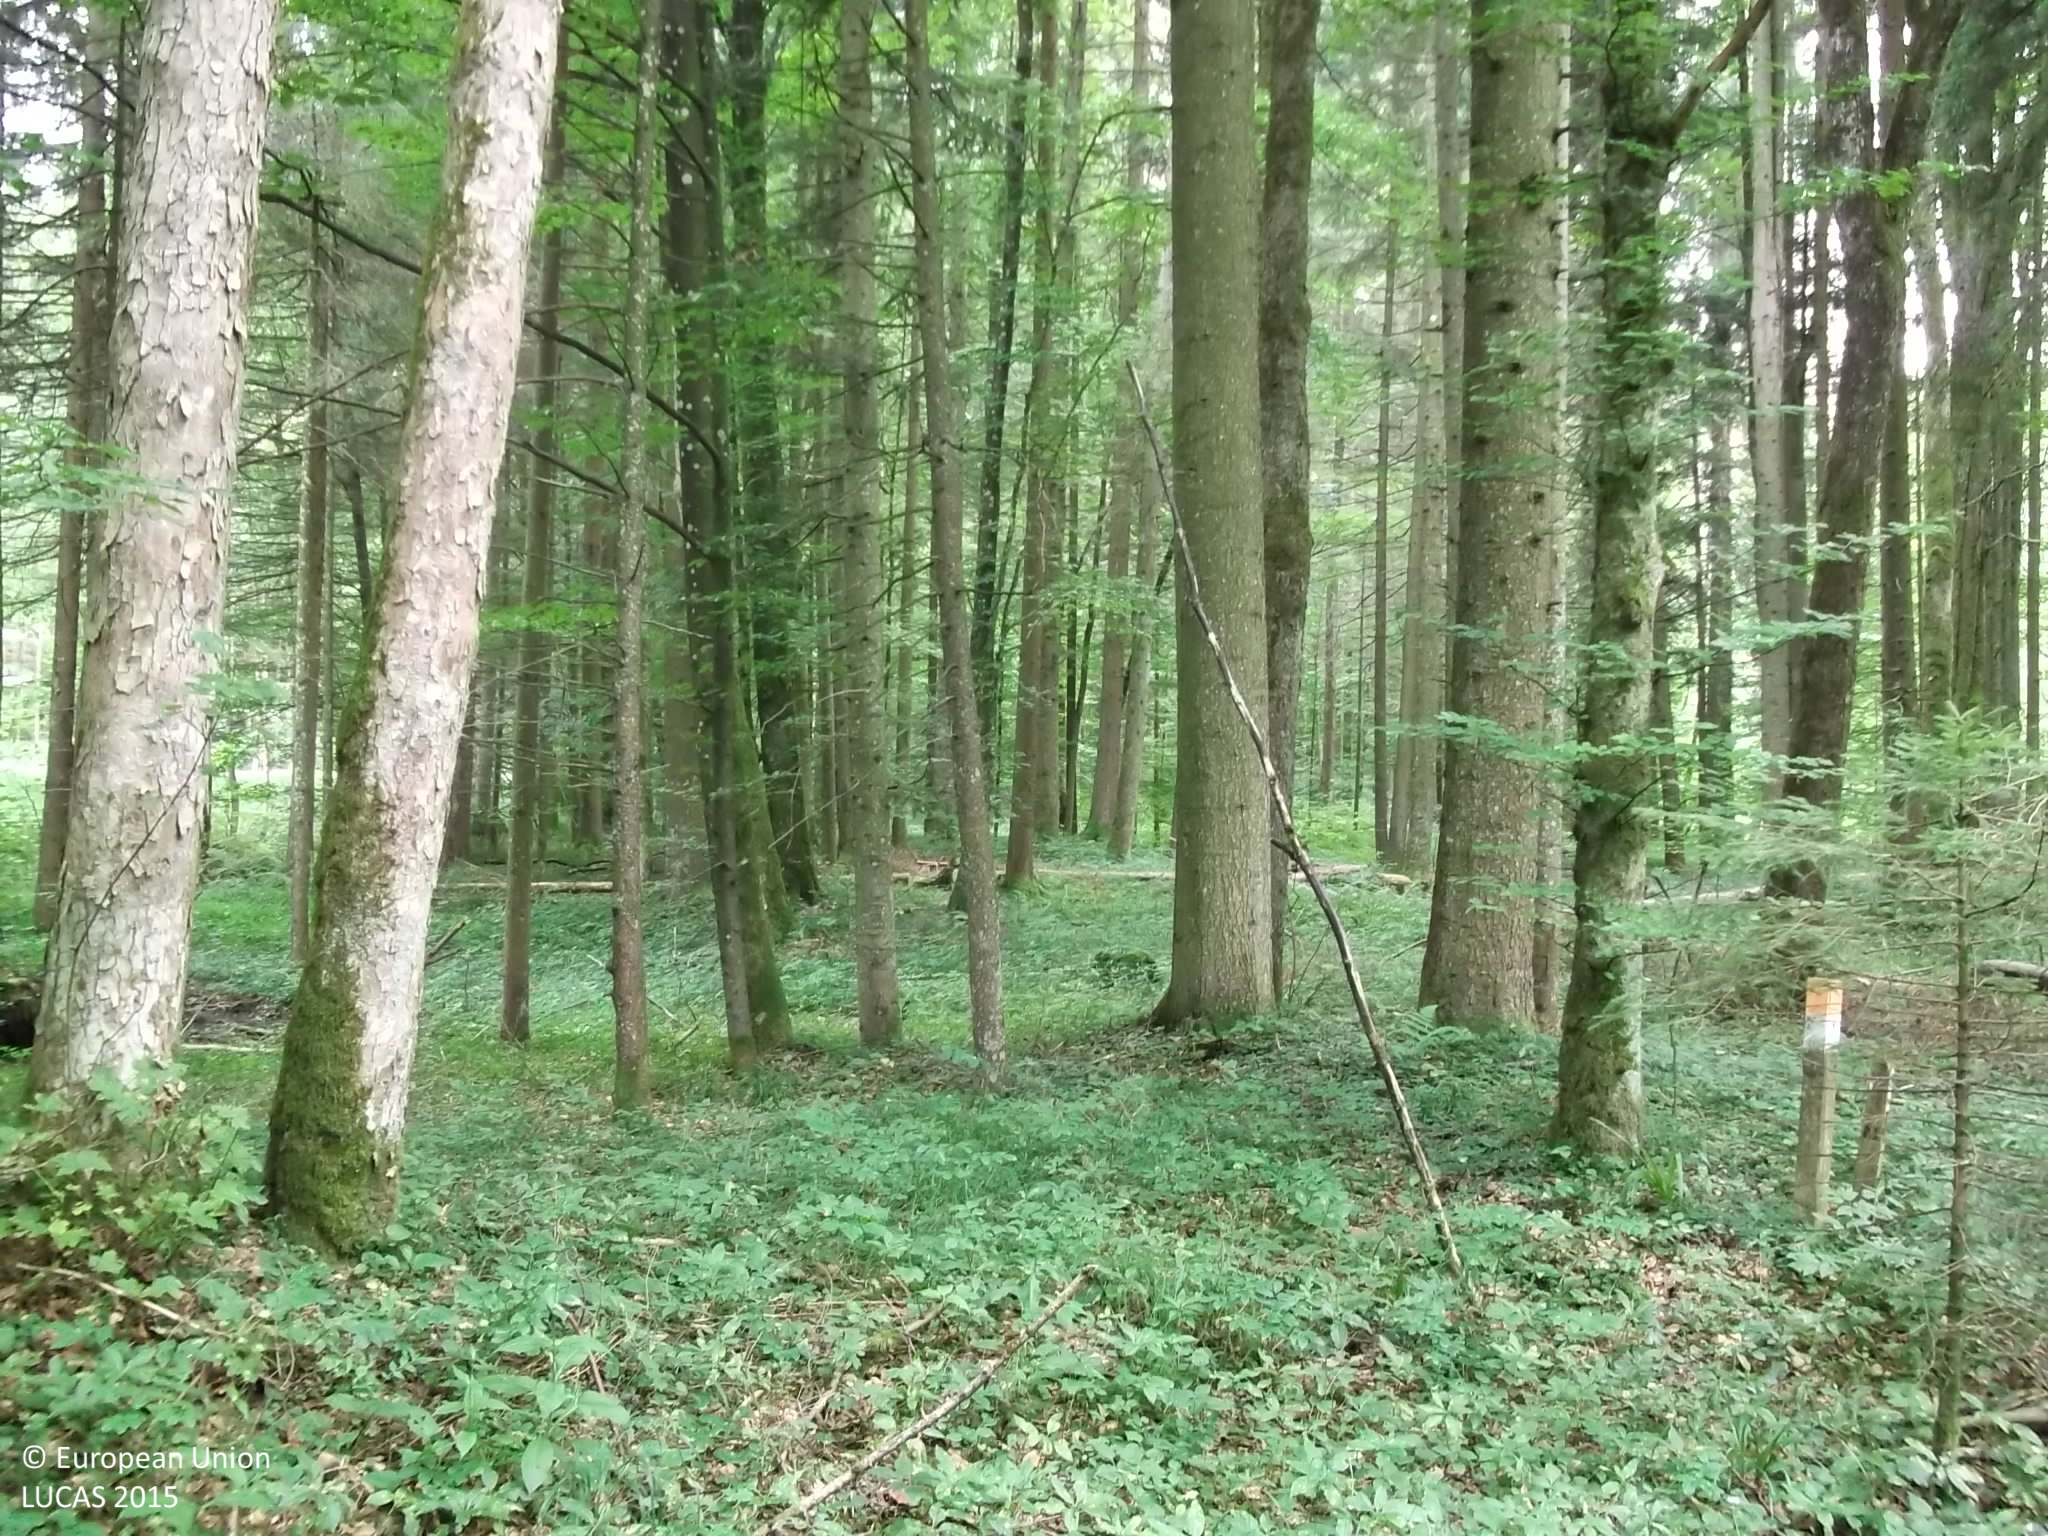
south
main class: Woodland
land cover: Spruce dominated mixed woodland
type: hemiboreal forest and nemoral coniferous forest and mixed broadleaved-coniferous forest
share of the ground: > 75 %
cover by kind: coniferous forest trees 45 %, broadleaved forest trees 40 %, herbaceous plants 15 %
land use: Forestry
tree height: > 5 m
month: August
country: AT
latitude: 47.9383
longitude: 13.3589
